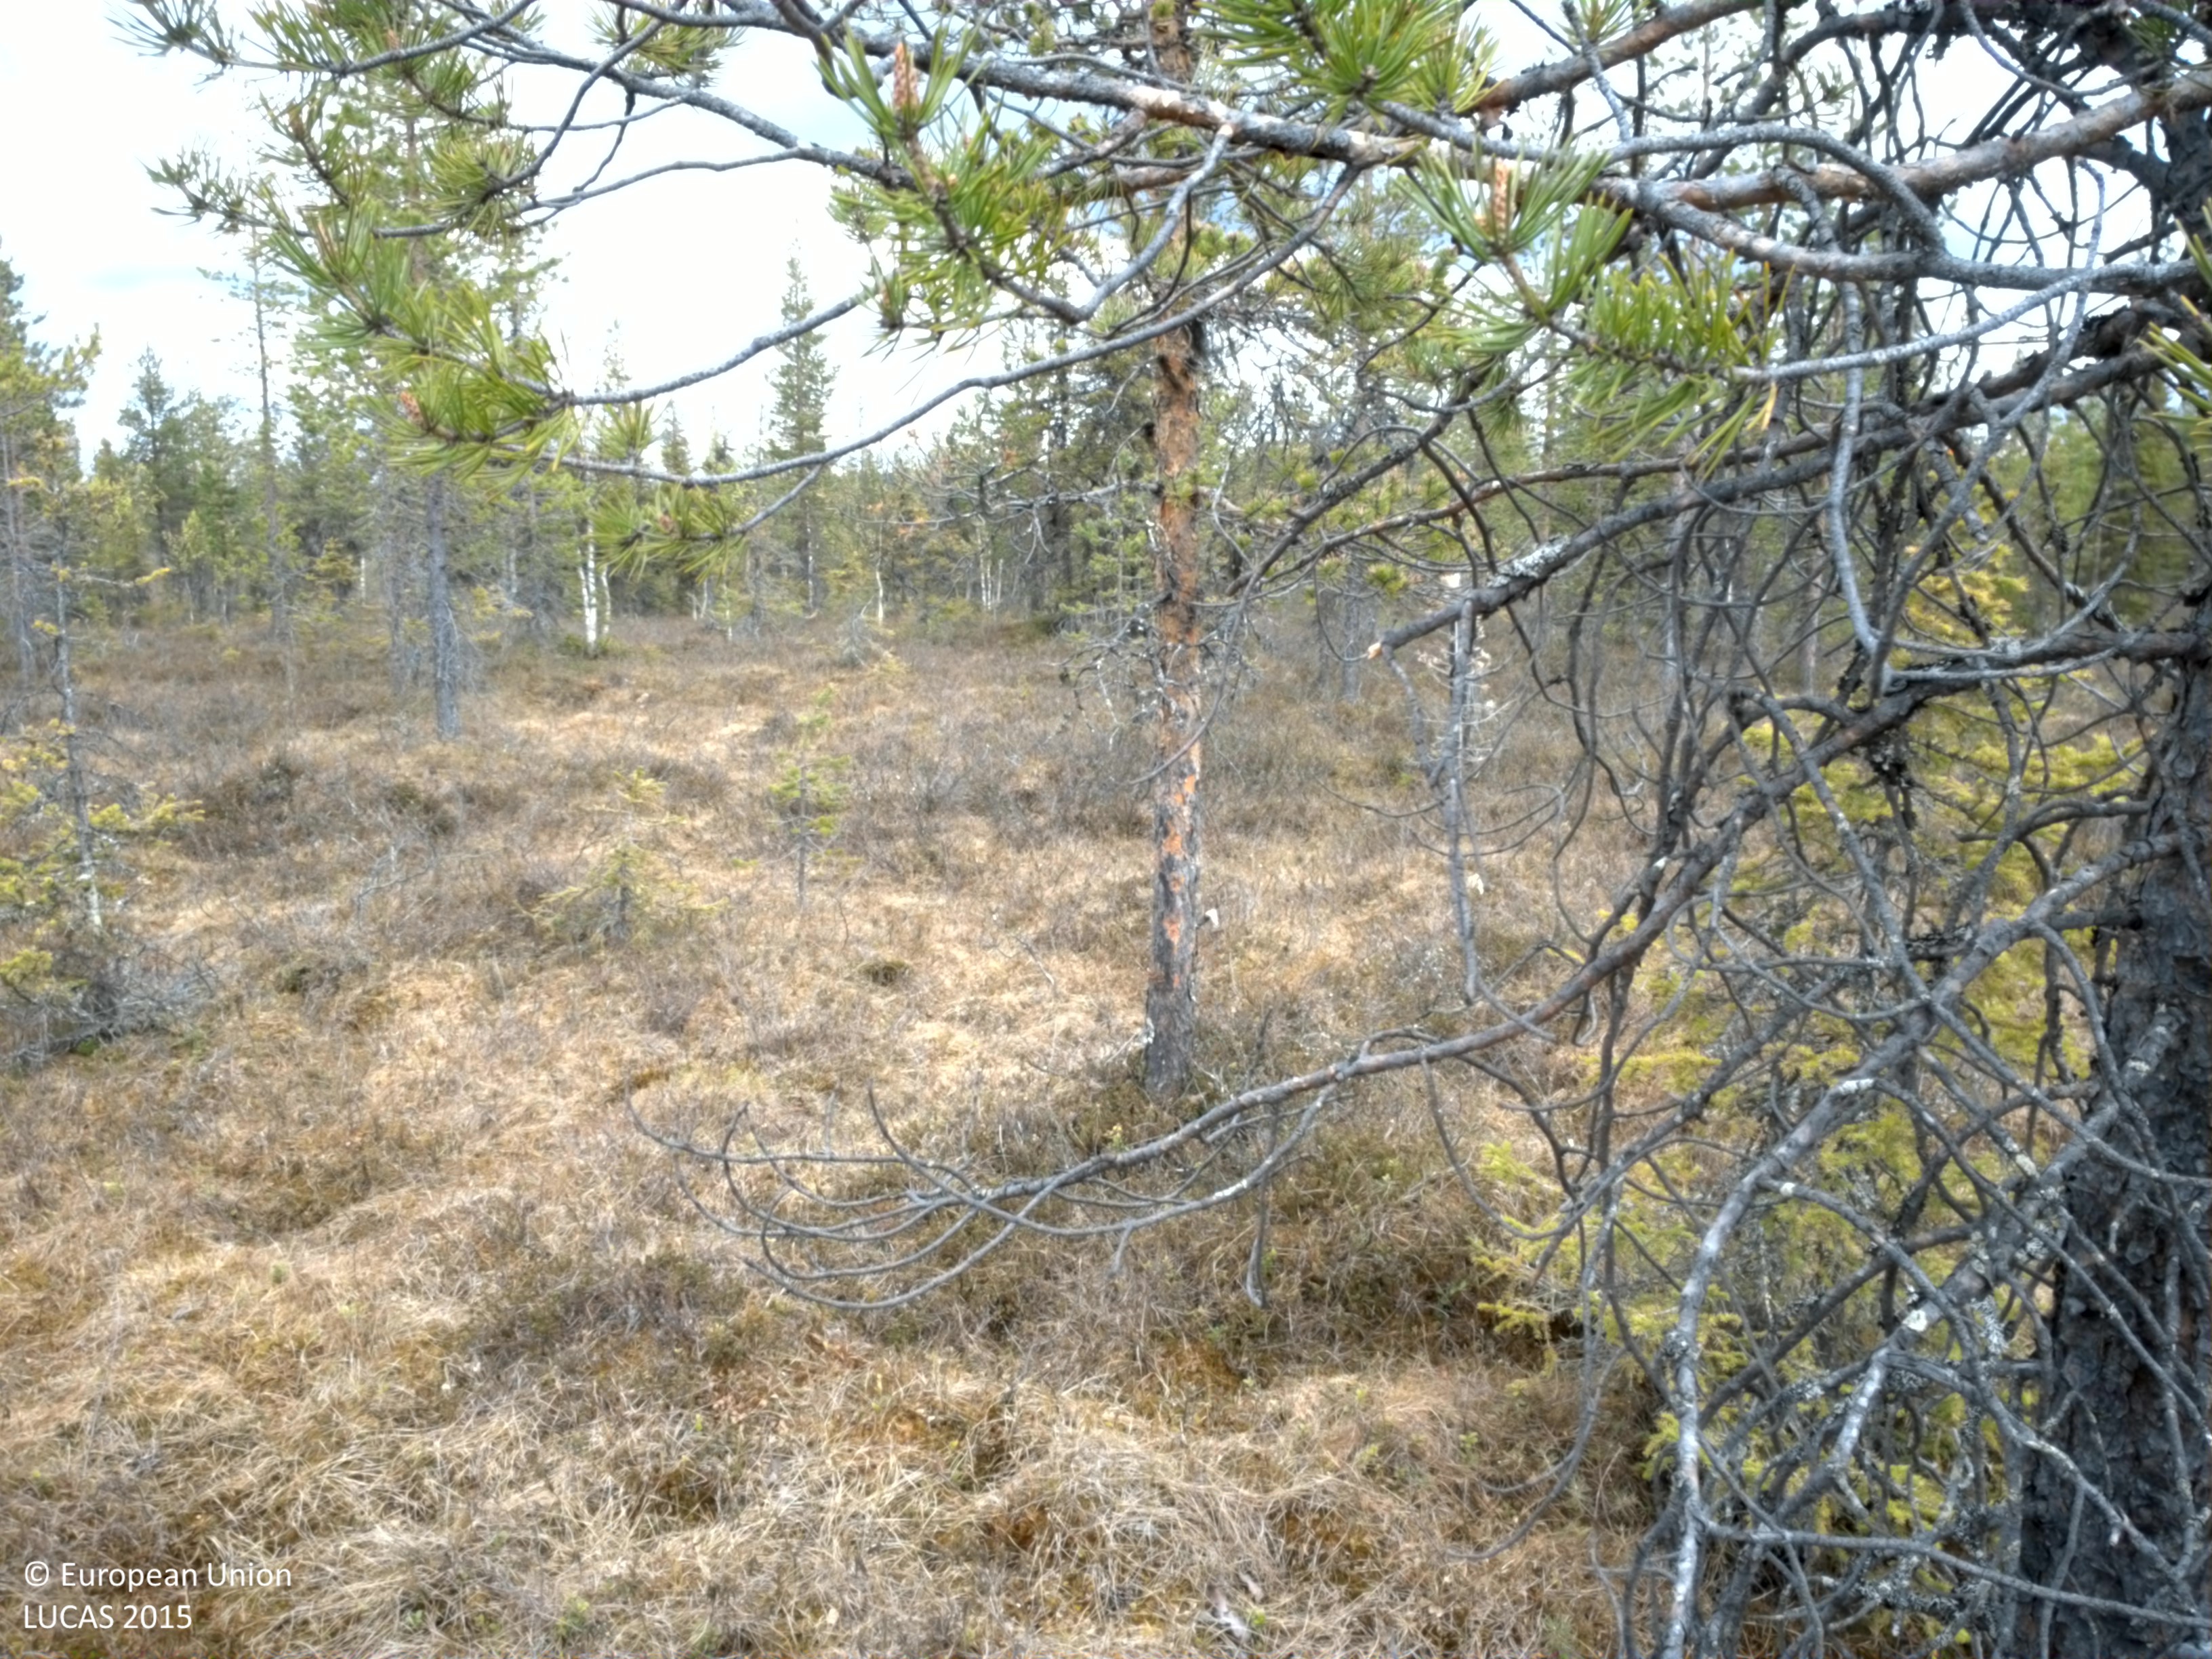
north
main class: Woodland
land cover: Pine dominated coniferous woodland
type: mire and swamp forests
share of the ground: 10 - 25 %
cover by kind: shrubs 50 %, herbaceous plants 35 %, coniferous forest trees 15 %
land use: Semi-natural and natural areas not in use
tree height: > 5 m
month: June
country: SE
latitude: 66.0823
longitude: 18.8192
